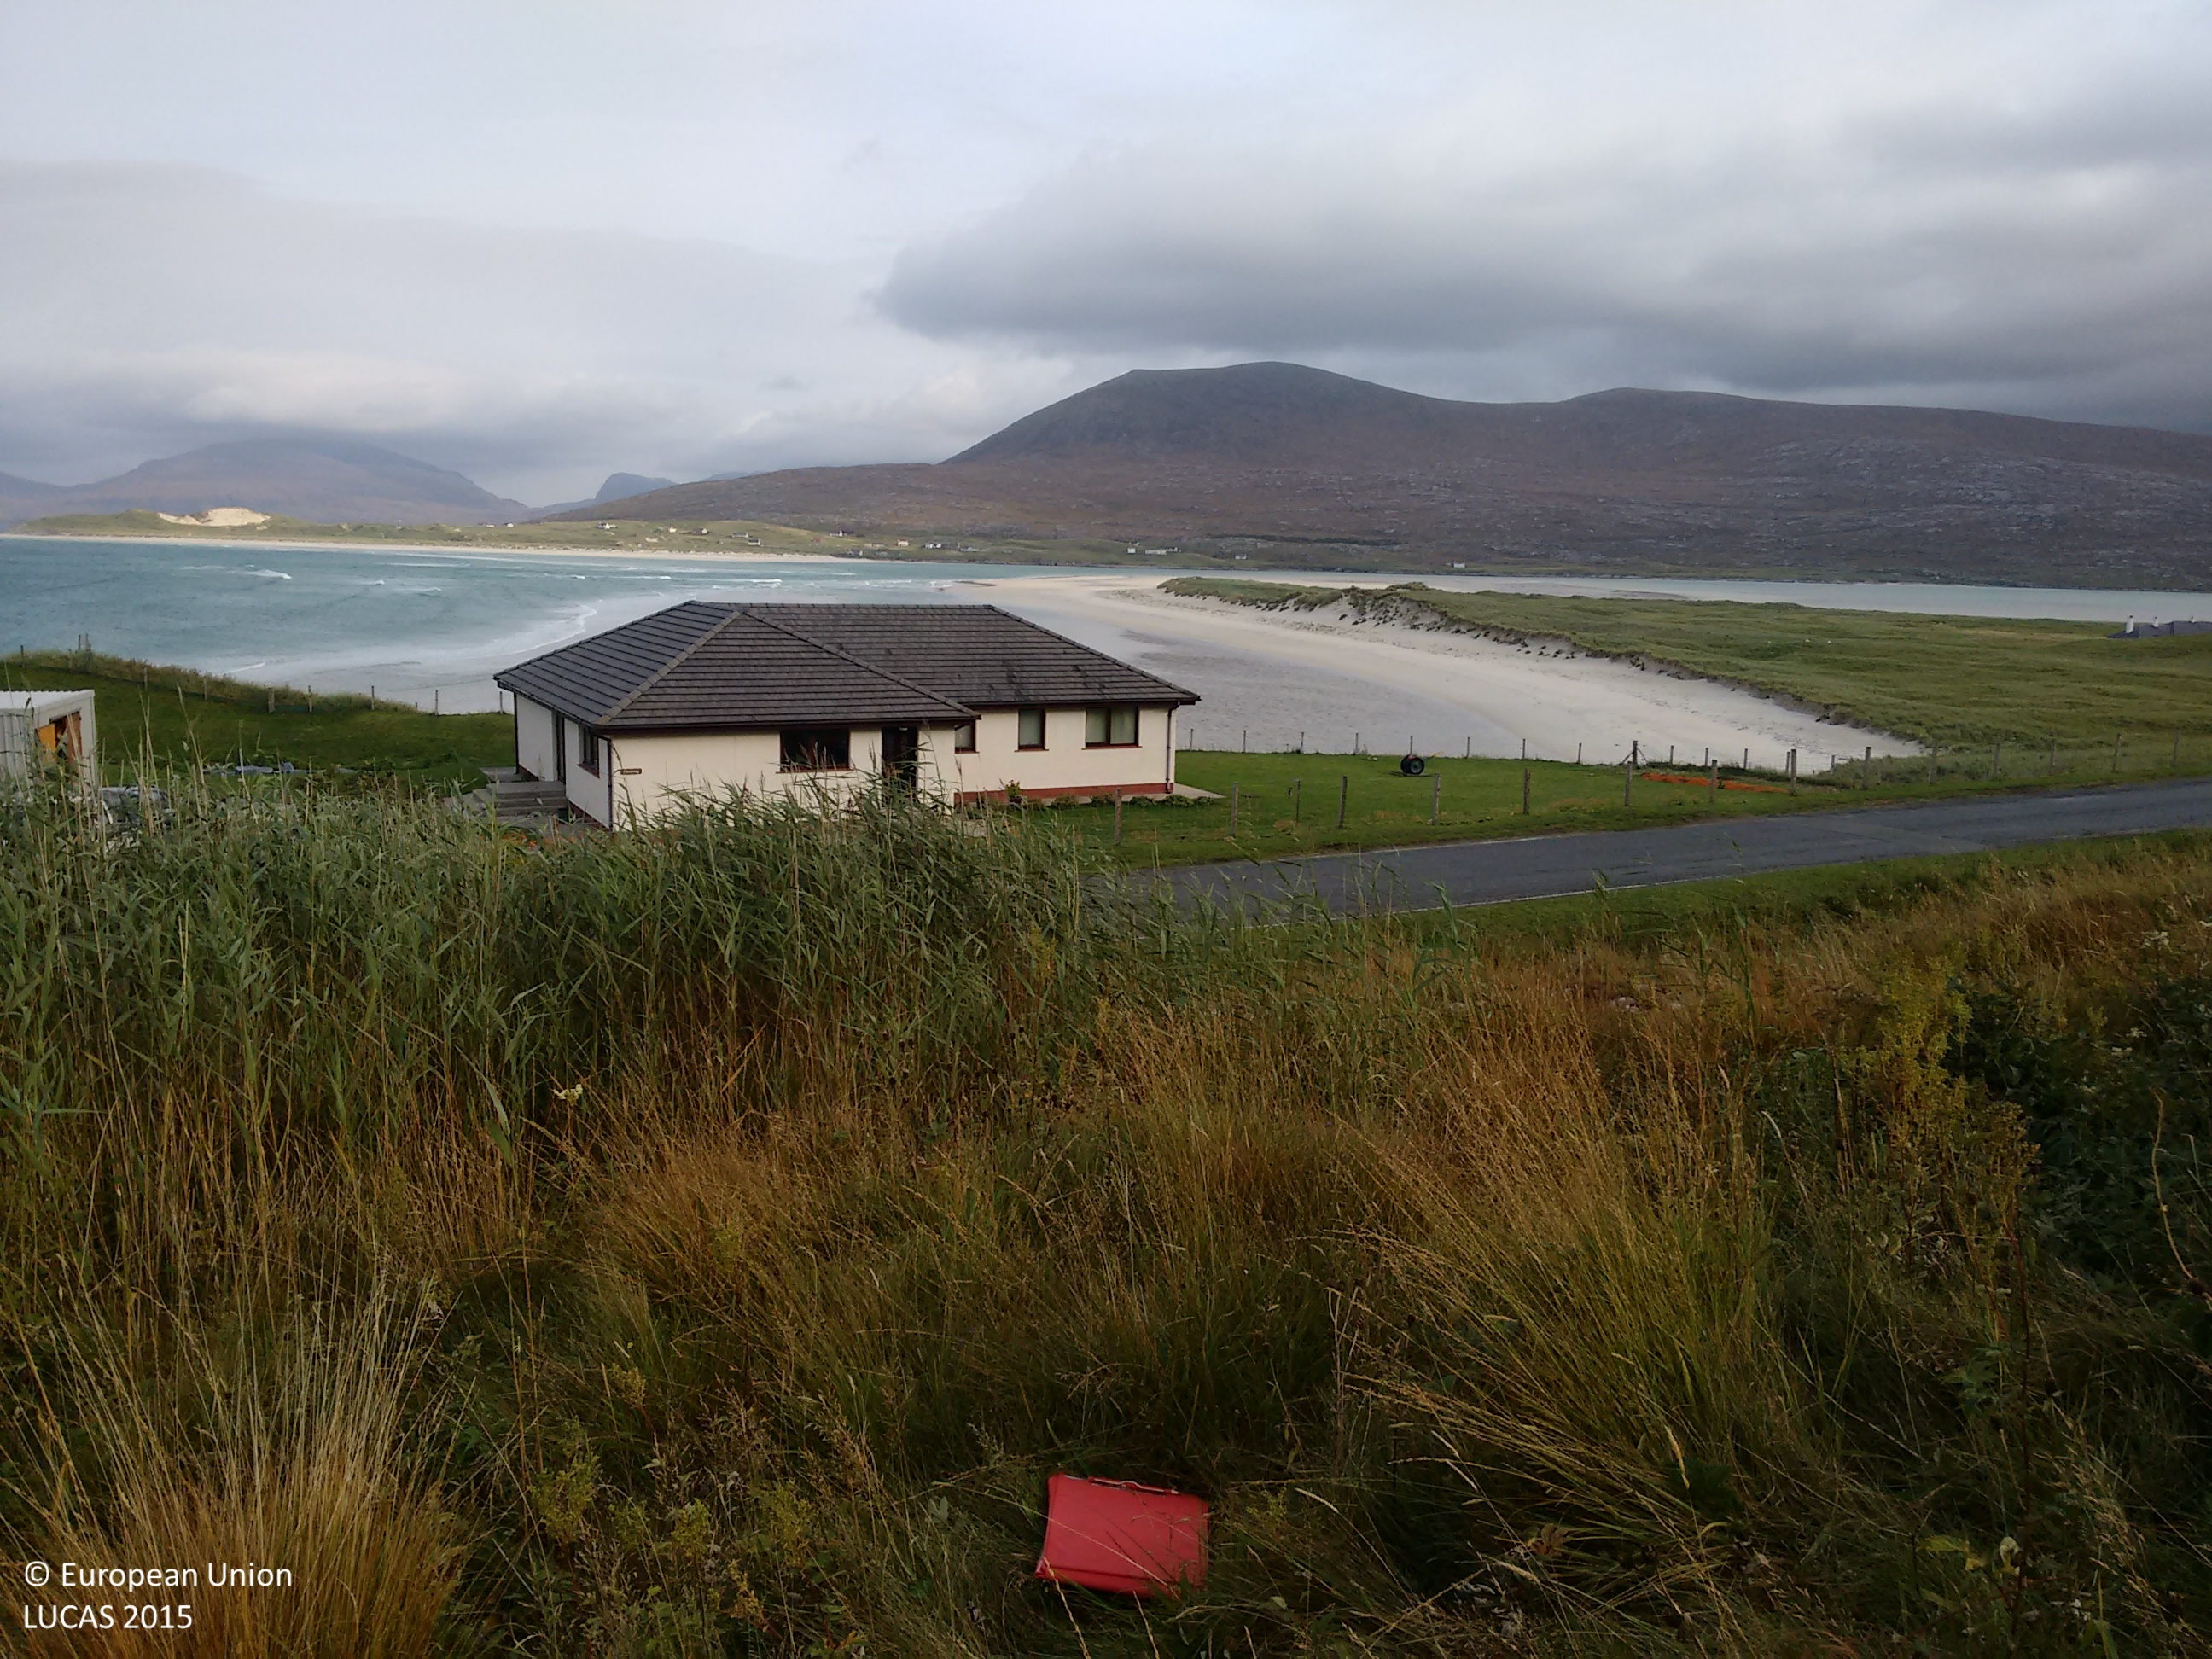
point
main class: Grassland
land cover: Grassland without tree/shrub cover
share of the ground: > 75 %
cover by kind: herbaceous plants 95 %
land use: Semi-natural and natural areas not in use
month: October
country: GB
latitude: 57.8670
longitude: -6.9605
